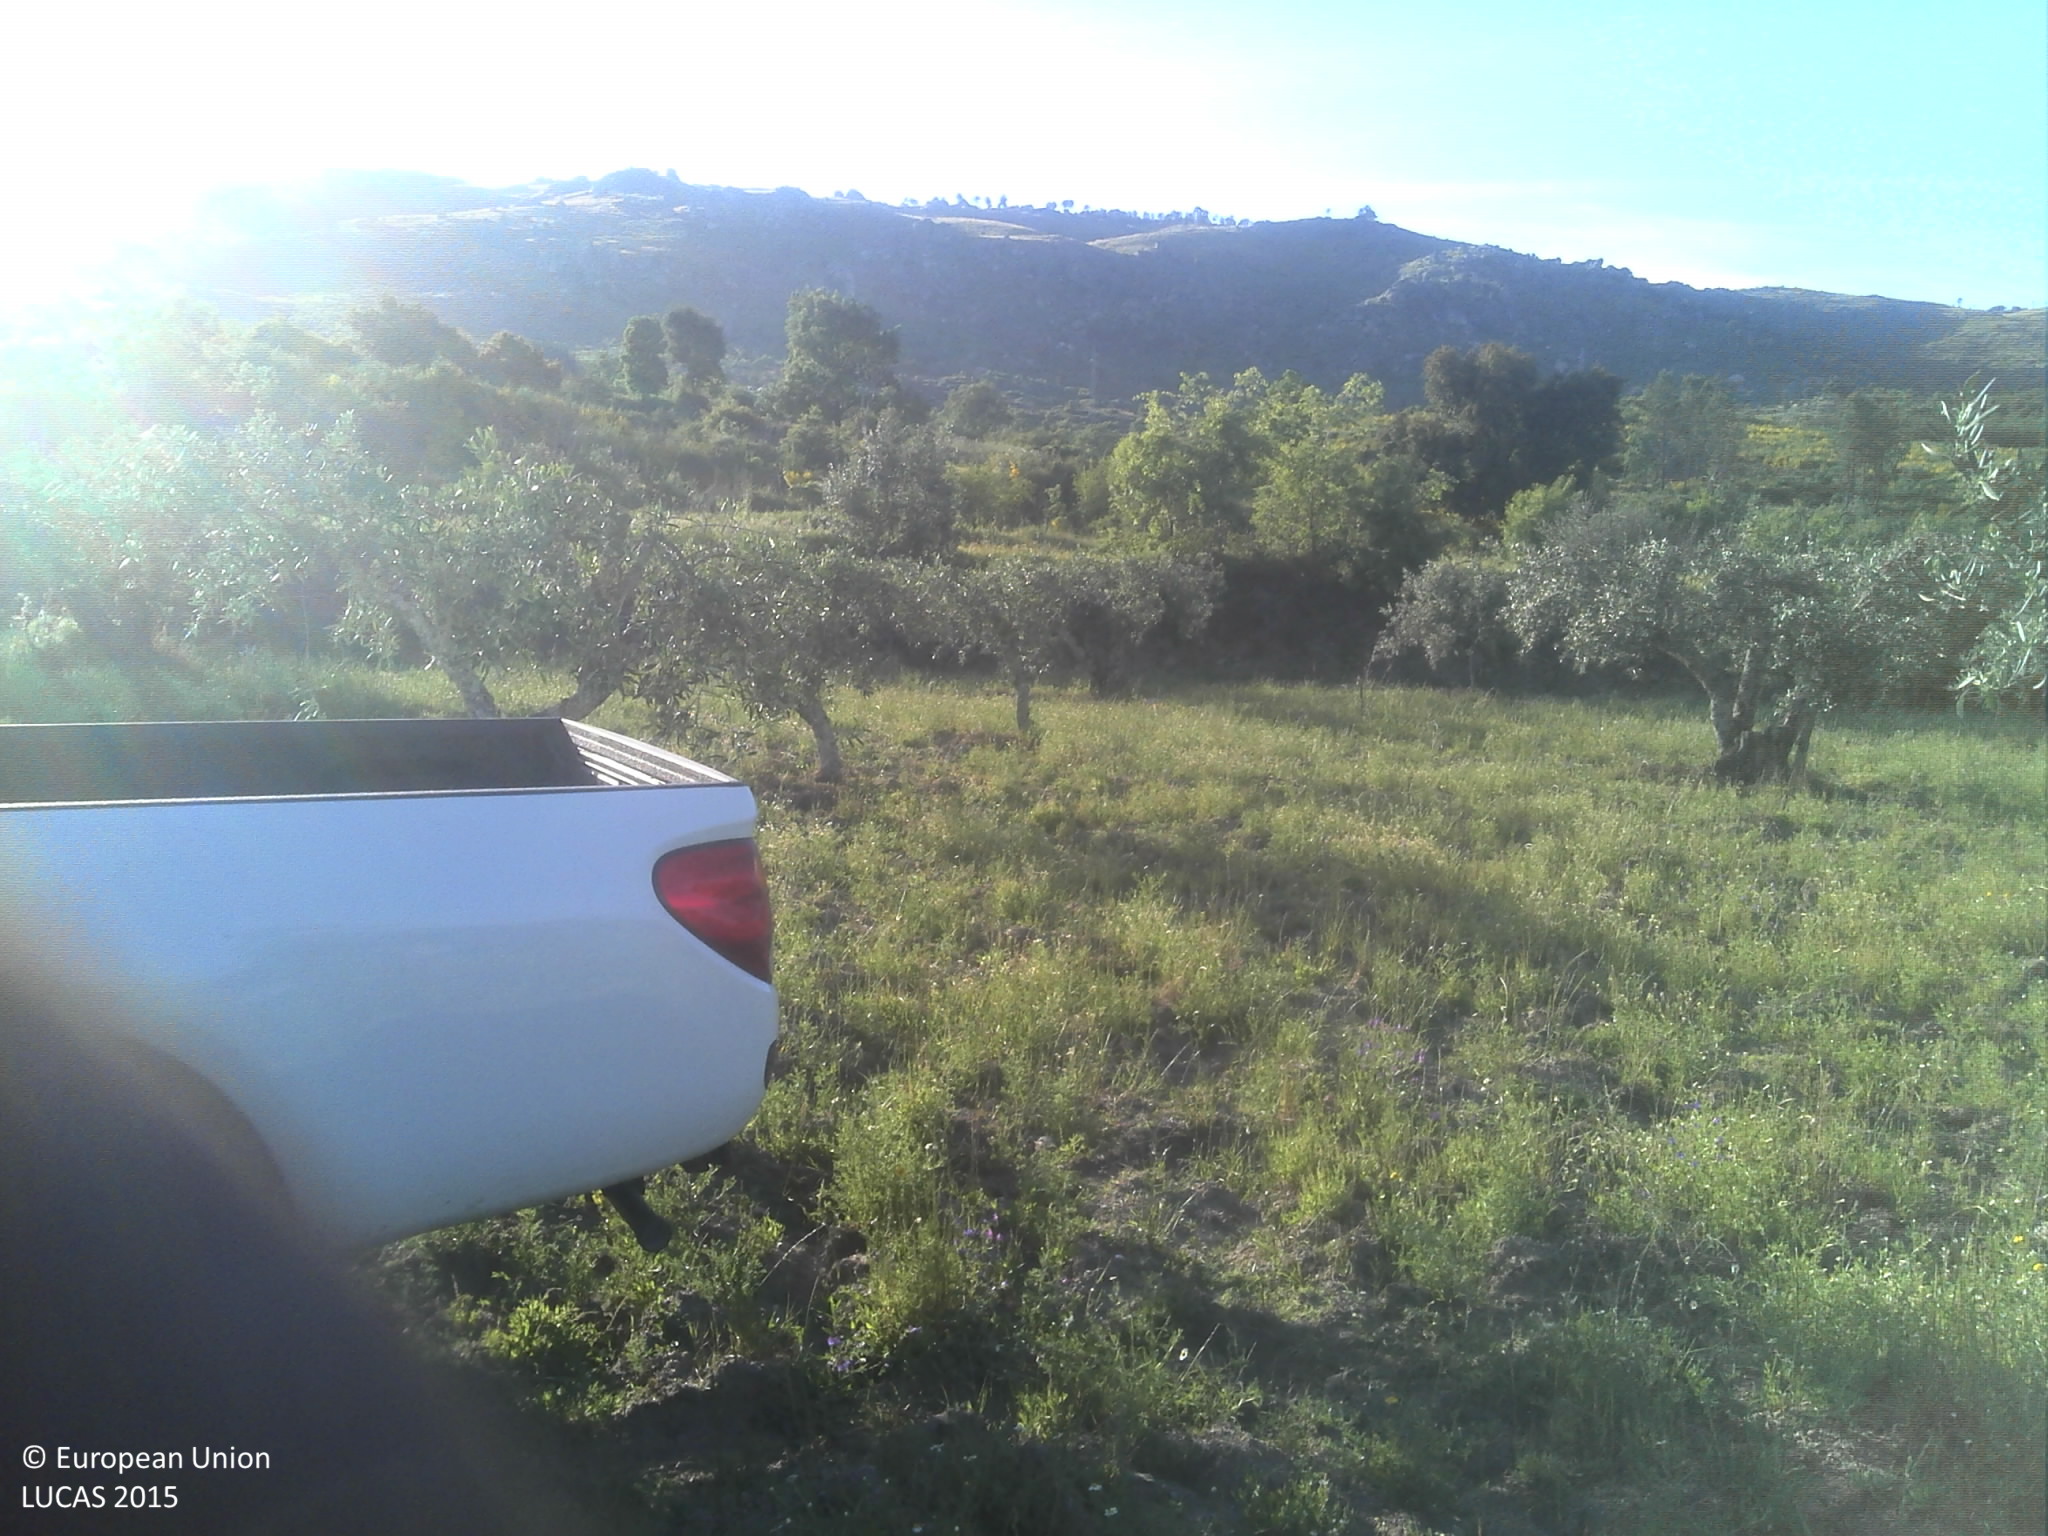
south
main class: Cropland
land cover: Olive groves
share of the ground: 25 - 50 %
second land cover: Grassland without tree/shrub cover
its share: 25 - 50 %
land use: Agriculture (excluding fallow land and kitchen gardens)
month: May
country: PT
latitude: 40.7174
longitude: -7.3592
